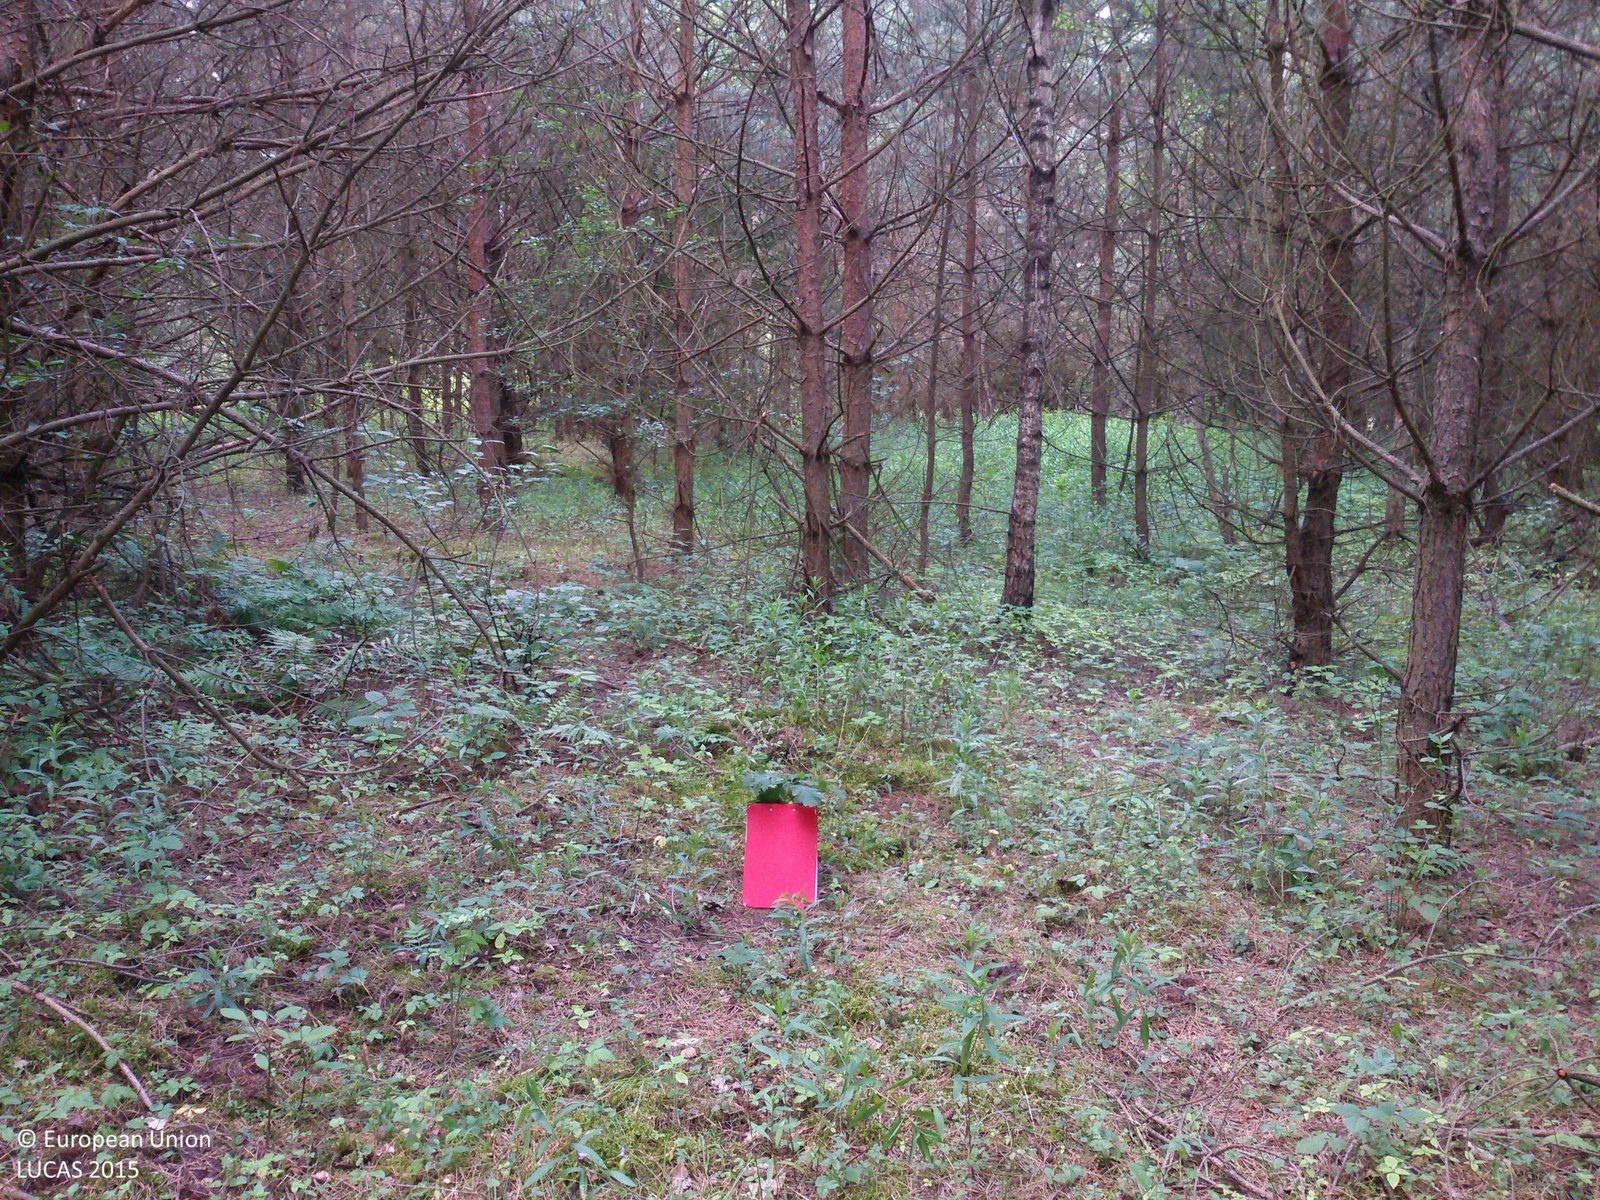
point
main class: Woodland
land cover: Pine dominated coniferous woodland
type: hemiboreal forest and nemoral coniferous forest and mixed broadleaved-coniferous forest
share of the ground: > 75 %
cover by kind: coniferous forest trees 90 %, herbaceous plants 10 %
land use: Forestry
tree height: > 5 m
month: June
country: PL
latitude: 50.8826
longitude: 21.7525
